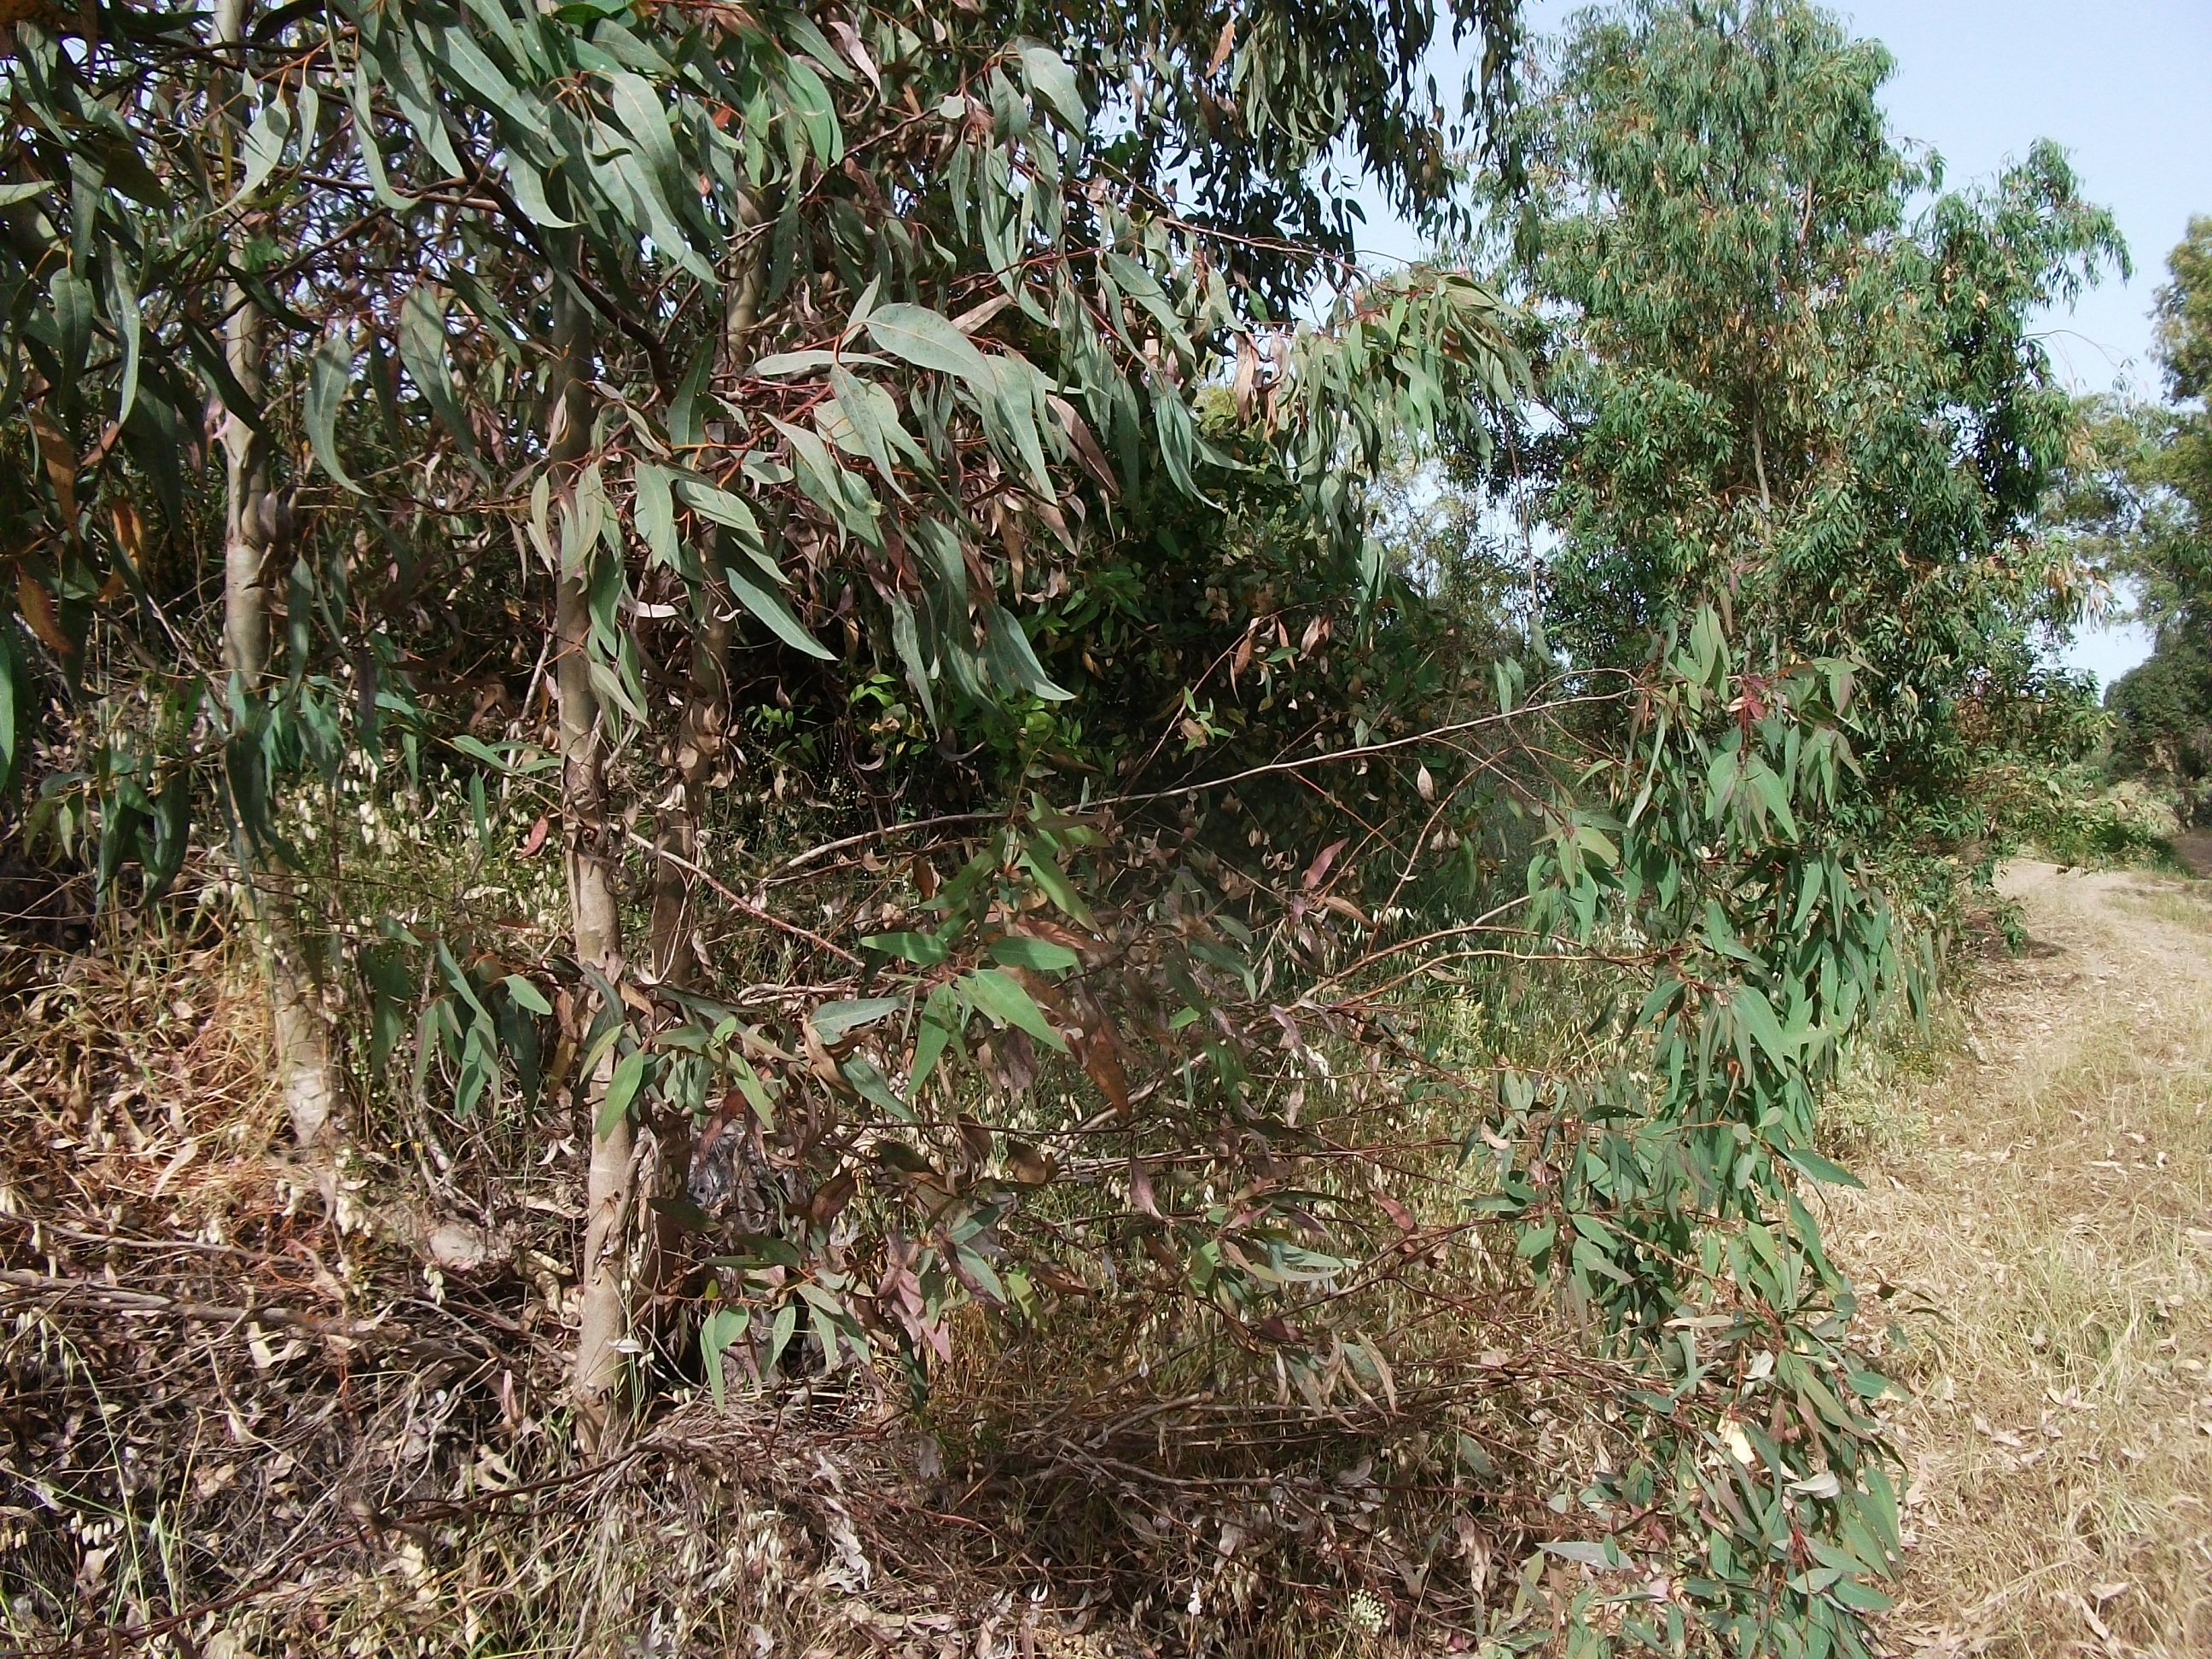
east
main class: Woodland
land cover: Broadleaved woodland
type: exotic forest
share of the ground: 10 - 25 %
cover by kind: herbaceous plants 80 %, broadleaved forest trees 20 %
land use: Semi-natural and natural areas not in use
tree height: > 5 m
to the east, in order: Broadleaved woodland; Ditches and canals; Shruby margins; Paved roads, cycling and walking lanes; Grass margins; Tracks; Ditches and canals; Pine dominated coniferous woodland
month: May
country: ES
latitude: 37.6906
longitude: -6.9557
